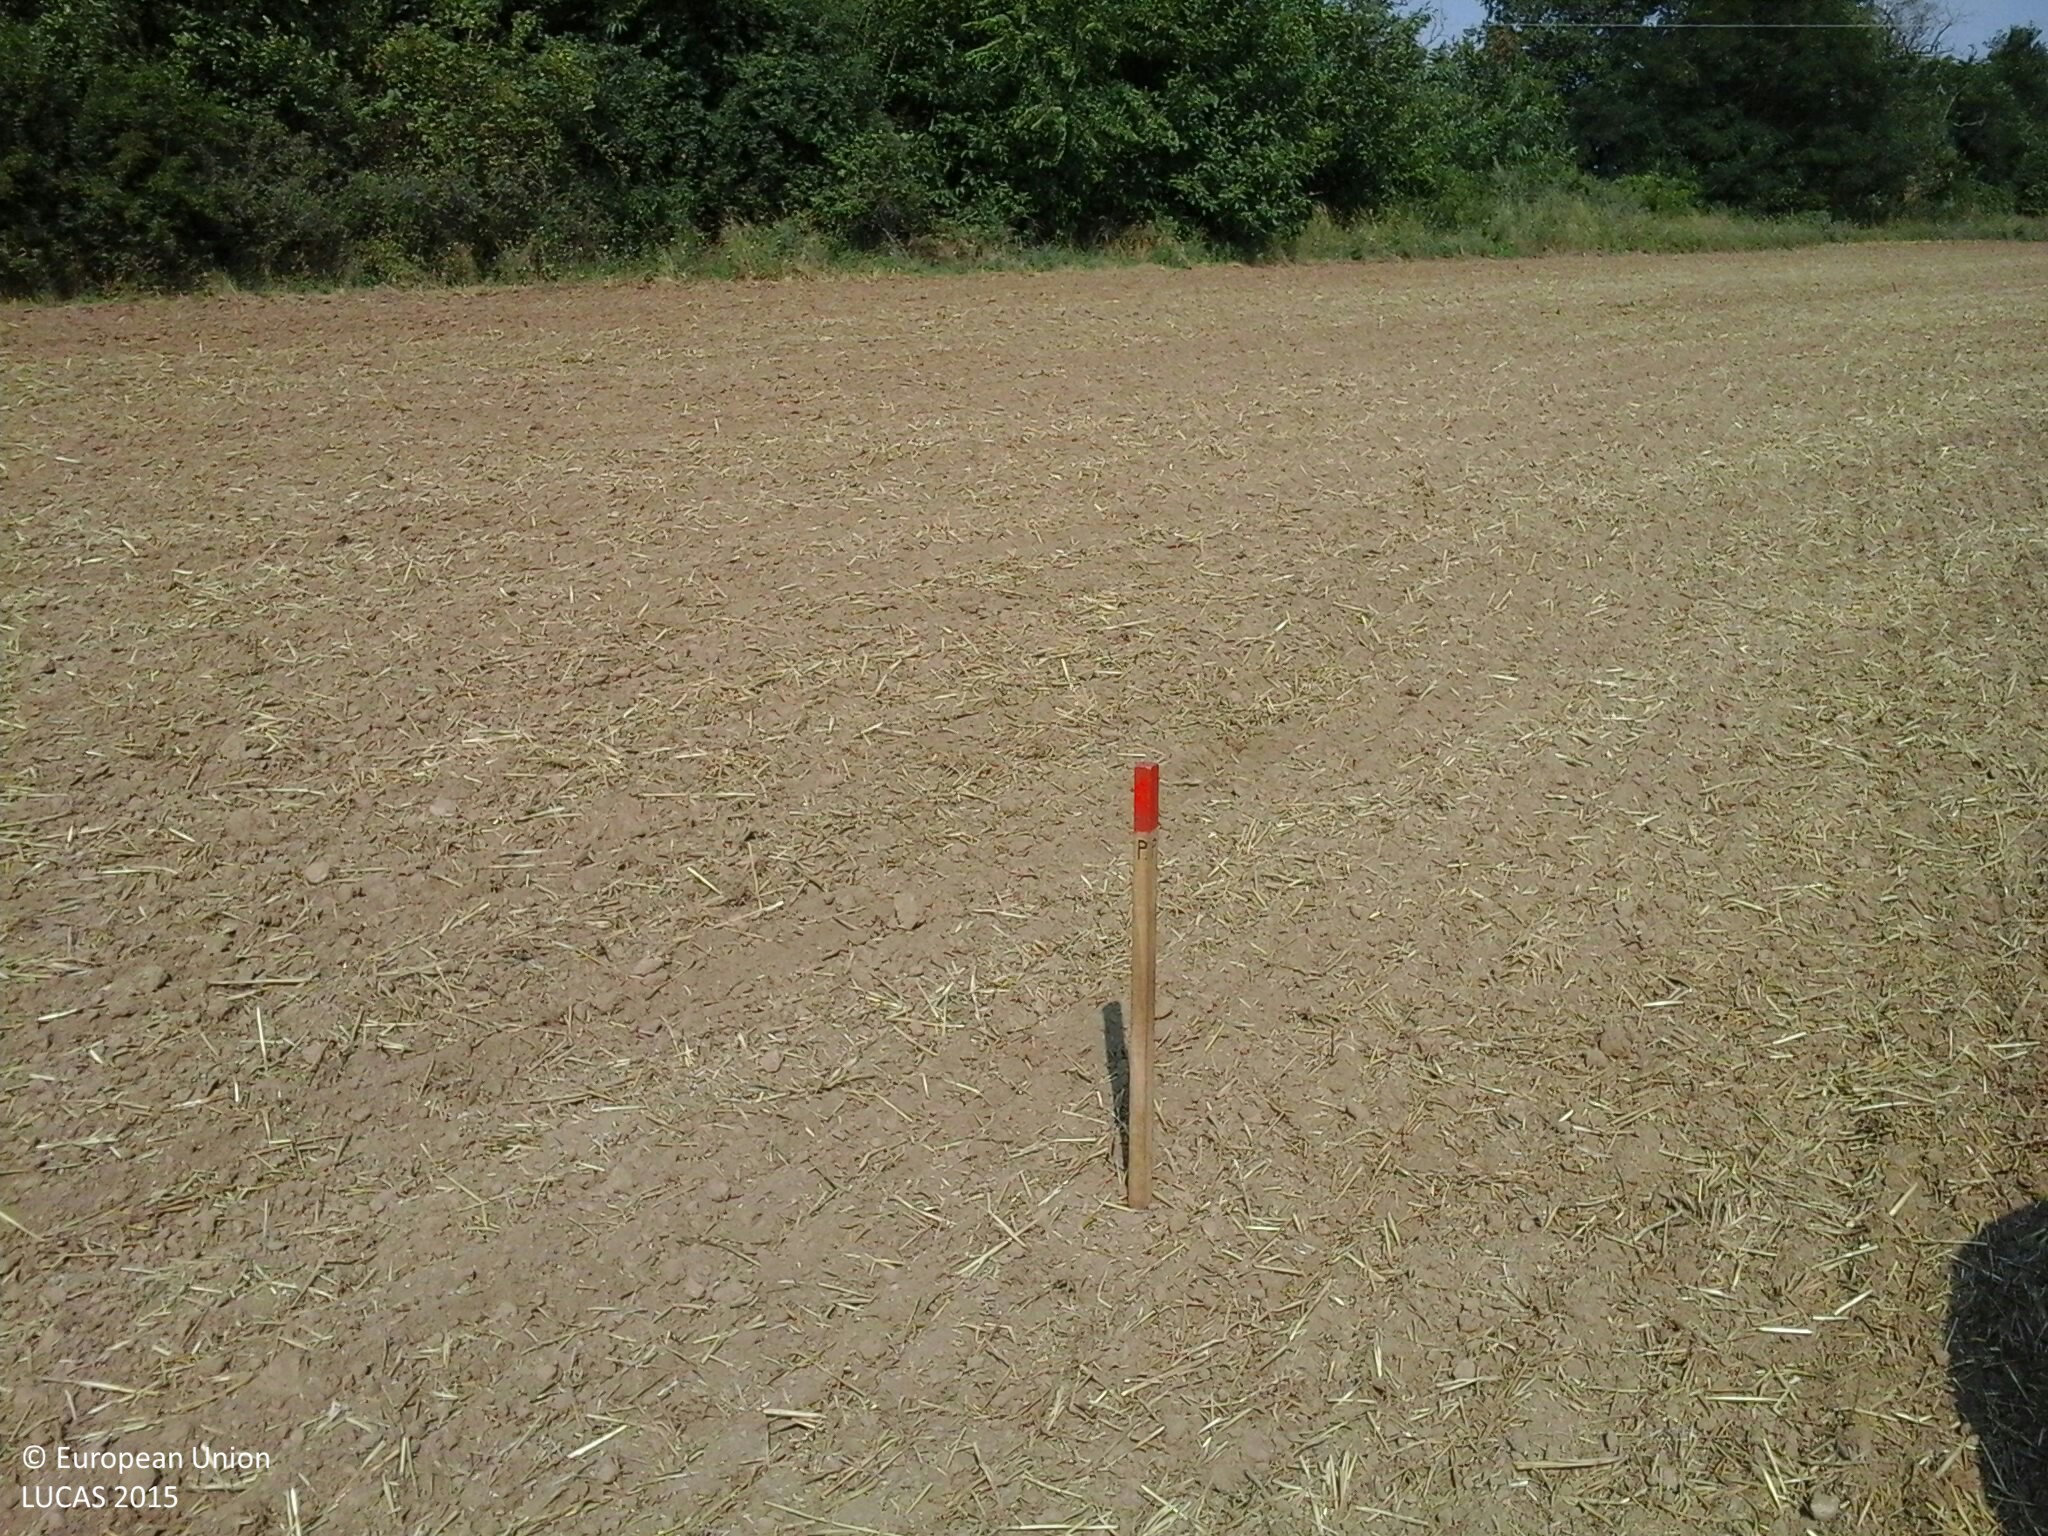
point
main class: Cropland
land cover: Durum wheat
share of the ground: < 10 %
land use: Agriculture (excluding fallow land and kitchen gardens)
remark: Harvested field
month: August
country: HU
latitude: 46.6669
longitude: 17.9939
